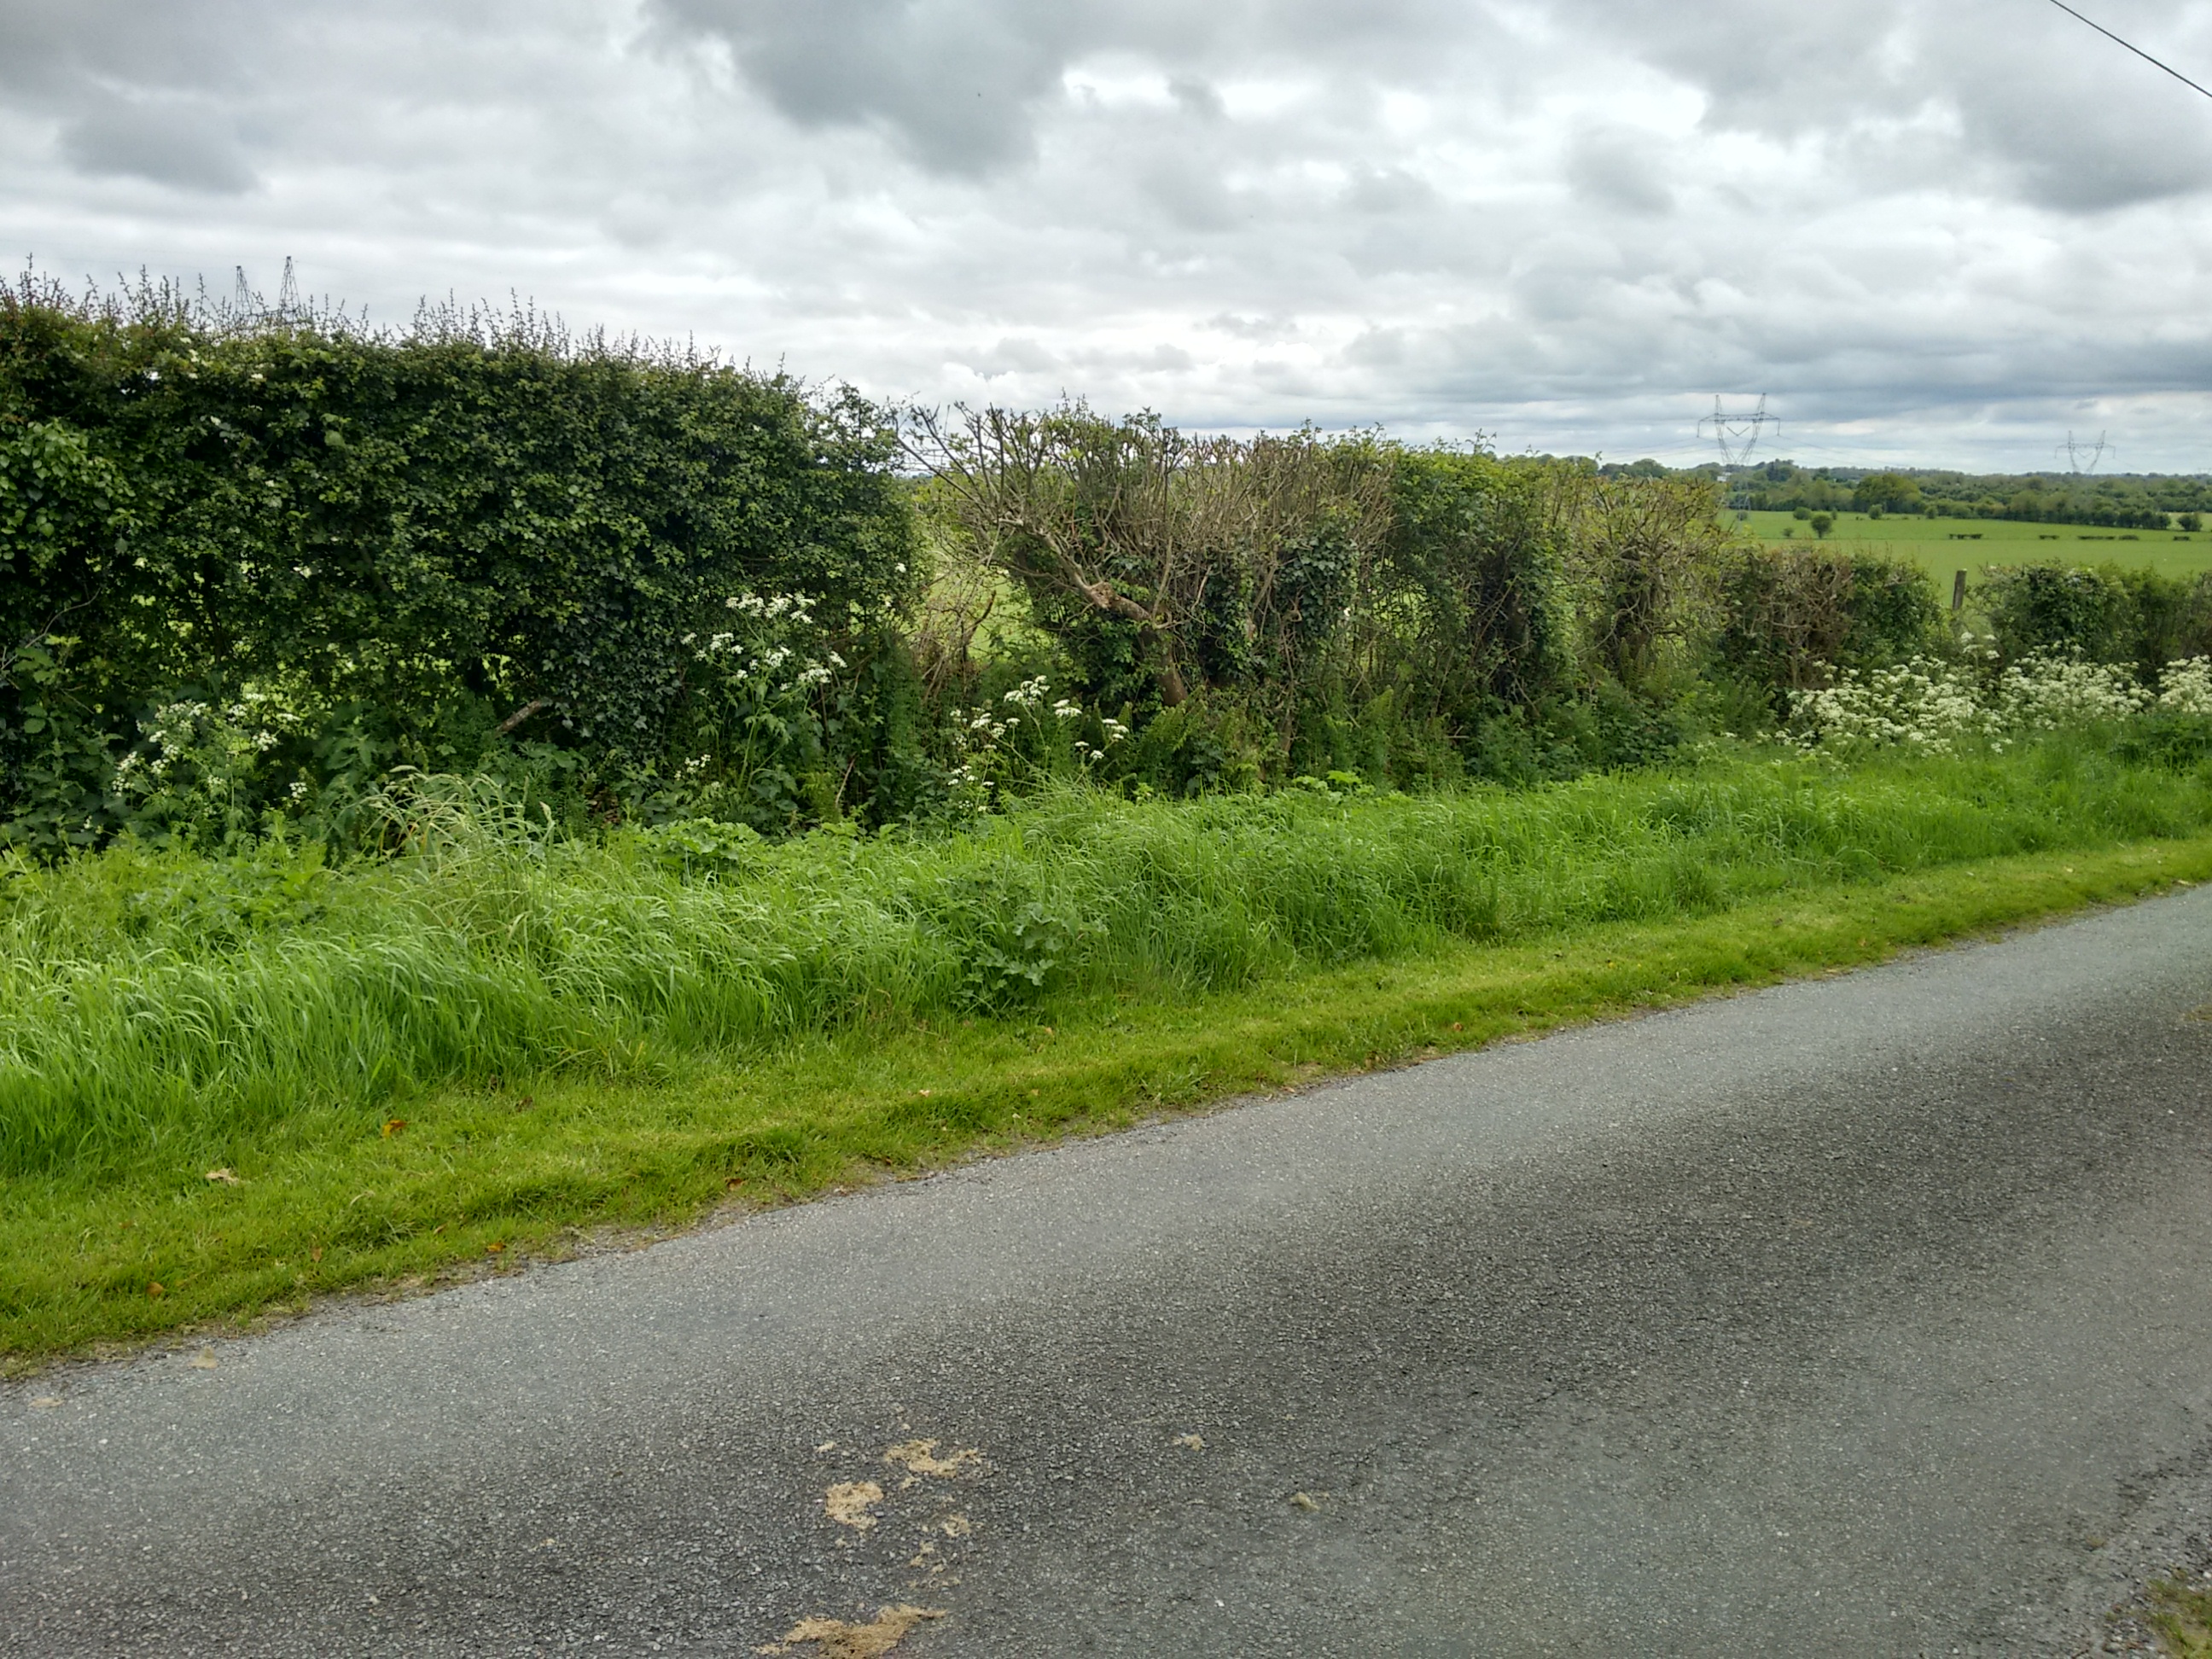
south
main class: Grassland
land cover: Grassland without tree/shrub cover
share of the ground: > 75 %
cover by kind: herbaceous plants 100 %
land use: Residential
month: May
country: IE
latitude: 53.4723
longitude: -6.6273
